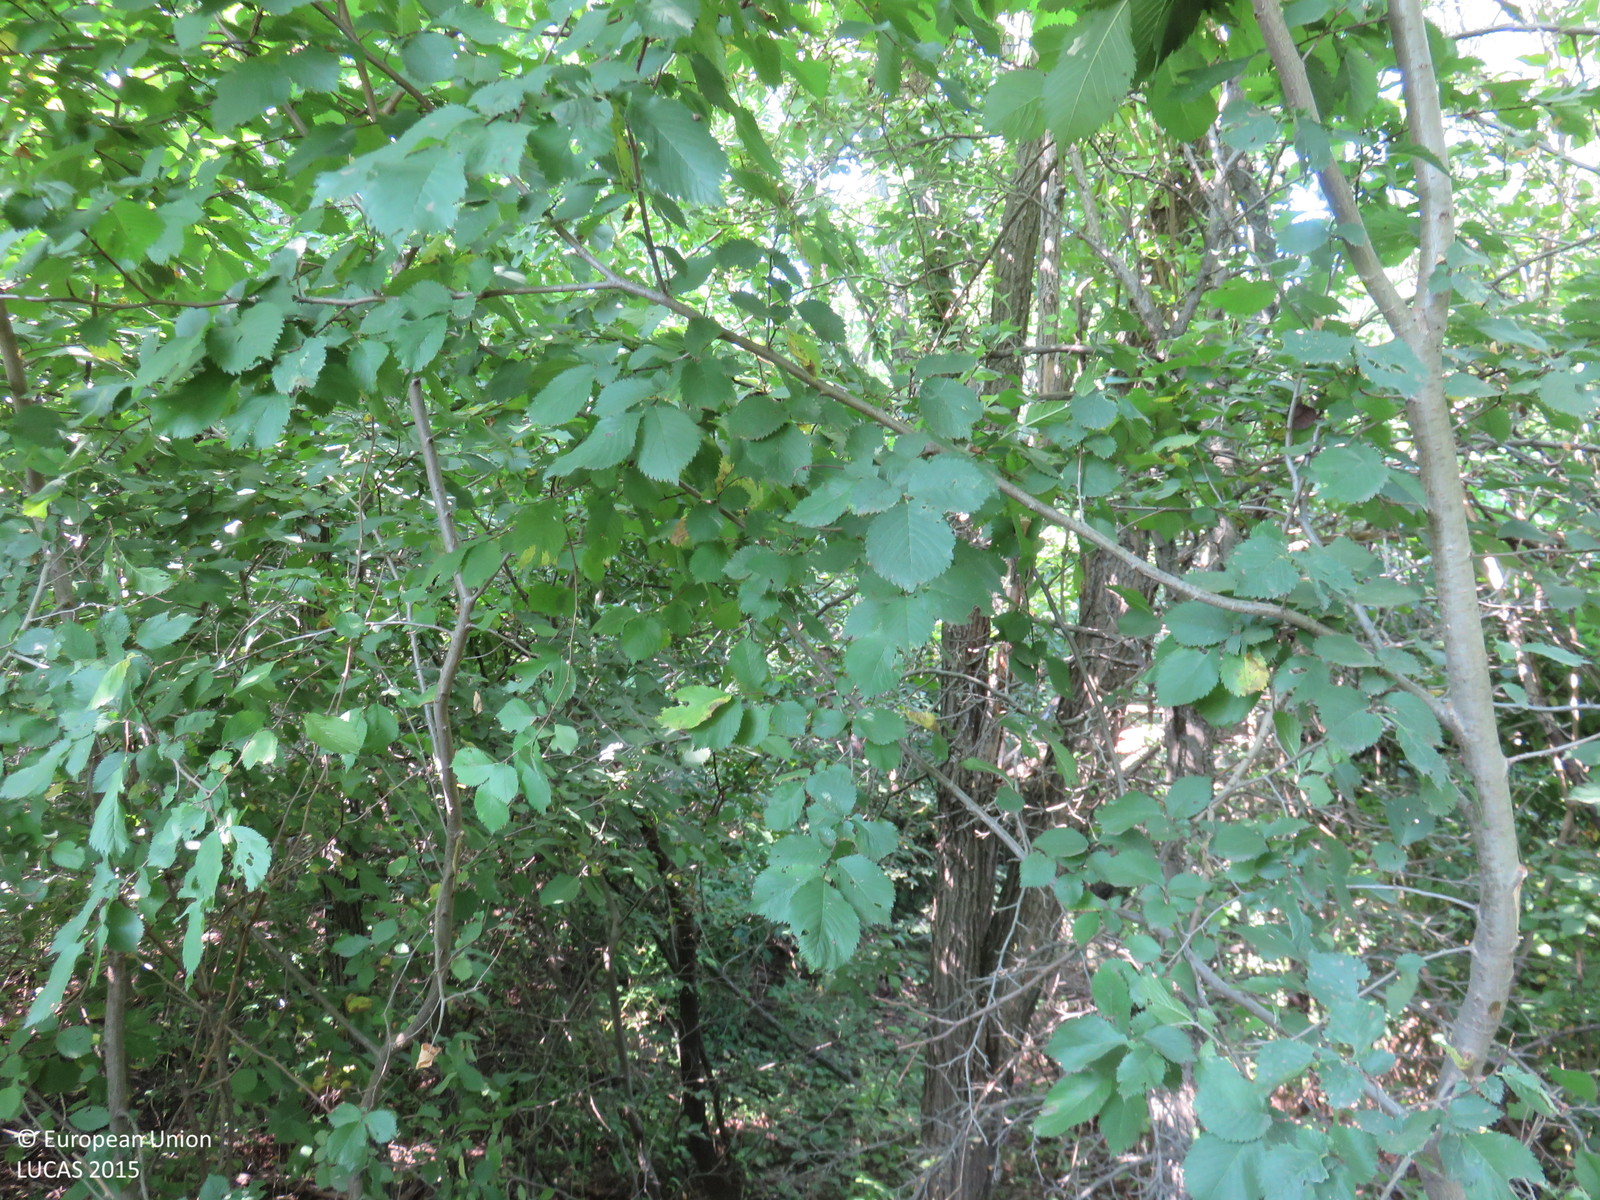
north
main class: Woodland
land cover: Broadleaved woodland
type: mesophytic deciduous forest
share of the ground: > 75 %
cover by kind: broadleaved forest trees 85 %, herbaceous plants 10 %, shrubs 5 %
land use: Forestry
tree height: < 5 m
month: July
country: BG
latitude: 43.5906
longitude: 24.9467
